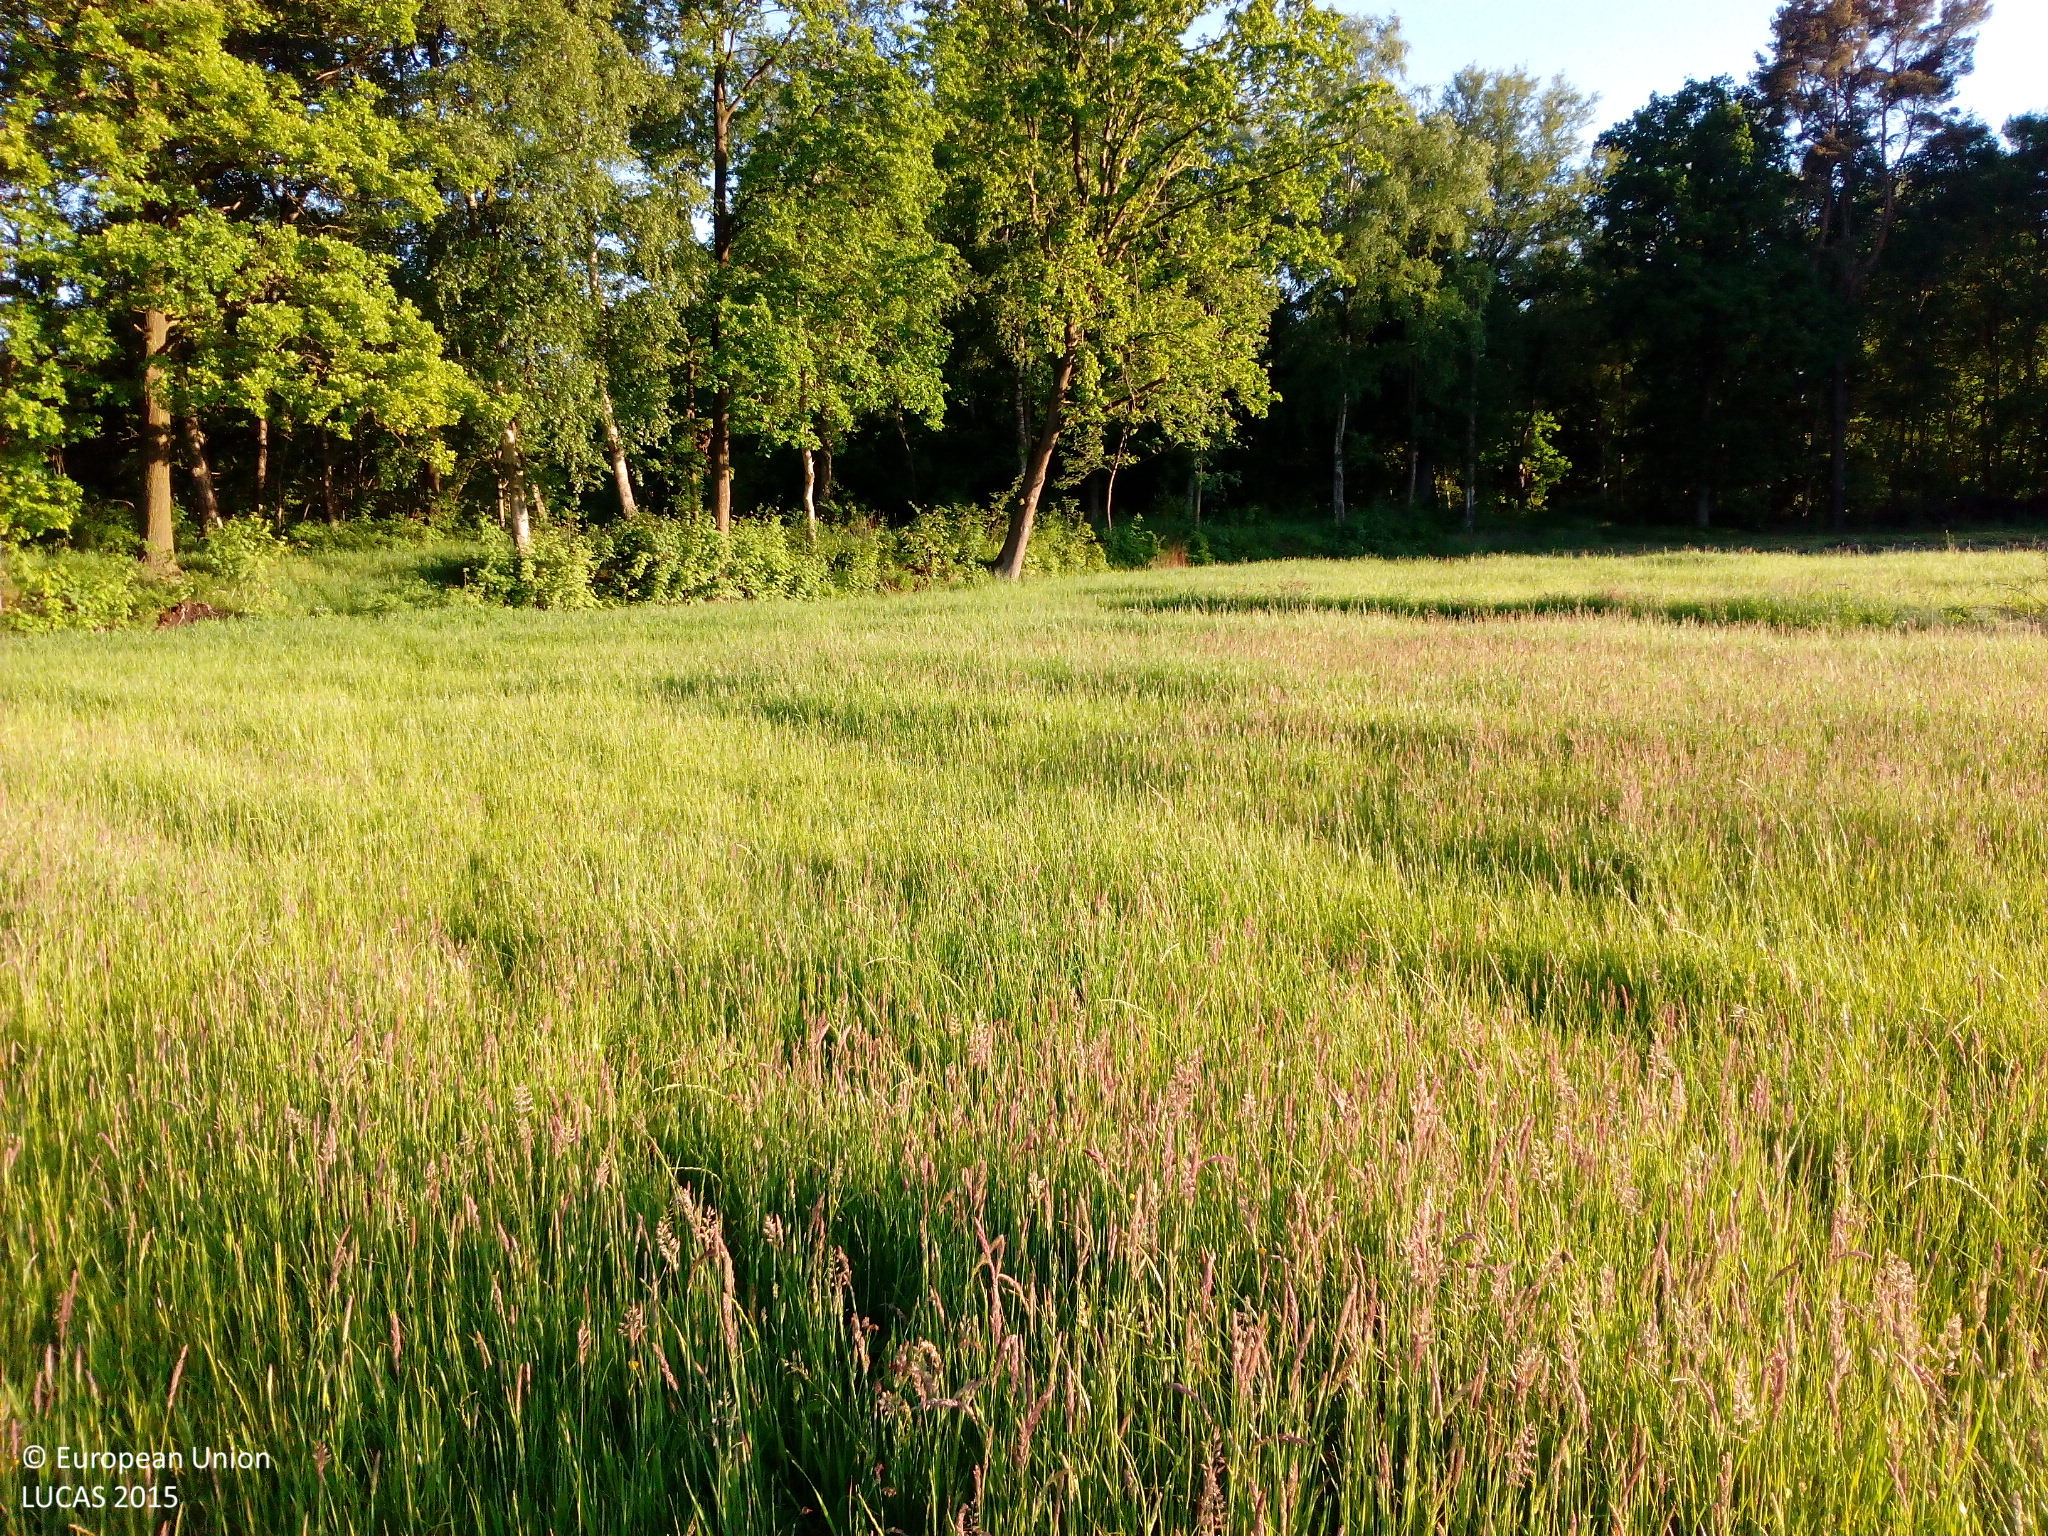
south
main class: Grassland
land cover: Grassland without tree/shrub cover
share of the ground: > 75 %
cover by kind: herbaceous plants 100 %
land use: Agriculture (excluding fallow land and kitchen gardens)
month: June
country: DE
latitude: 53.4890
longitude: 9.1715
